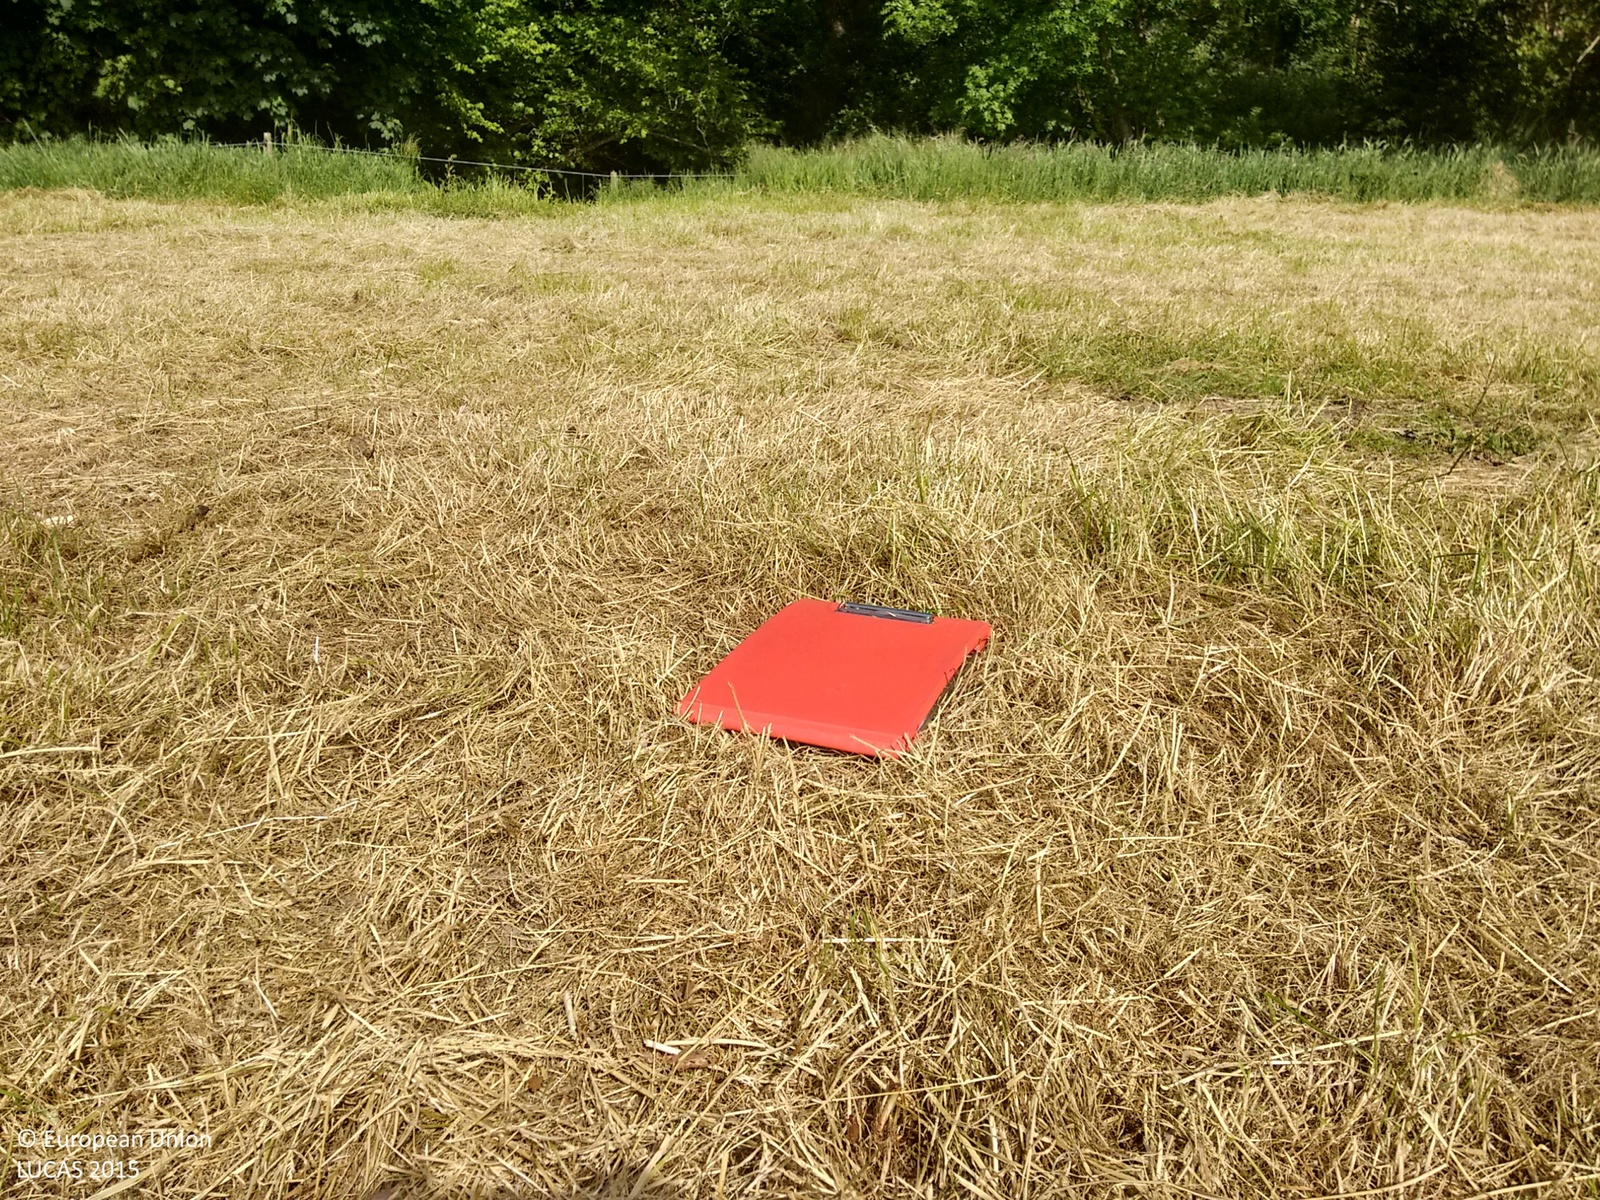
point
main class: Grassland
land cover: Grassland without tree/shrub cover
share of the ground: > 75 %
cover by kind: herbaceous plants 100 %
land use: Agriculture (excluding fallow land and kitchen gardens)
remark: Harvested field
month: June
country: IE
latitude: 51.9443
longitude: -7.9970
